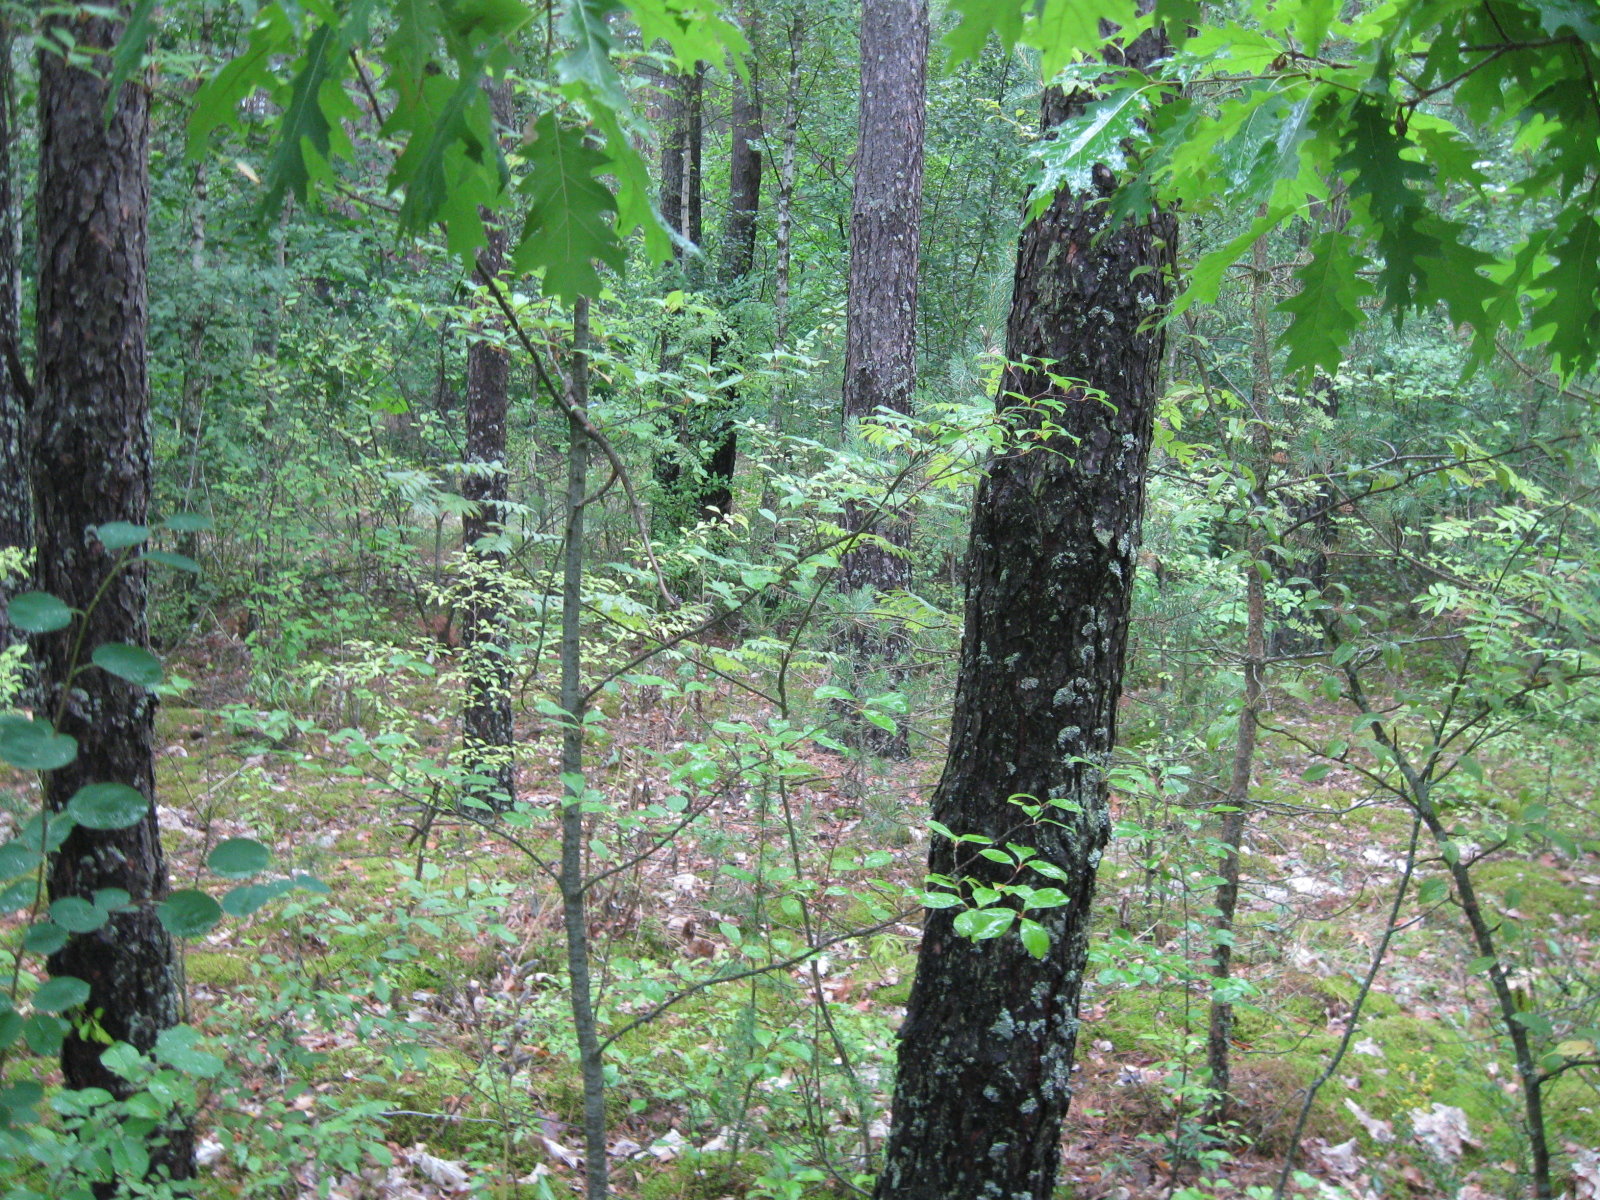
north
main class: Woodland
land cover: Pine dominated mixed woodland
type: hemiboreal forest and nemoral coniferous forest and mixed broadleaved-coniferous forest
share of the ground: > 75 %
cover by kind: coniferous forest trees 50 %, broadleaved forest trees 30 %, herbaceous plants 10 %, shrubs 5 %, lichens and mosses 5 %
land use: Forestry
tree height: > 5 m
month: July
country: LT
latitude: 53.9934
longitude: 23.6459
